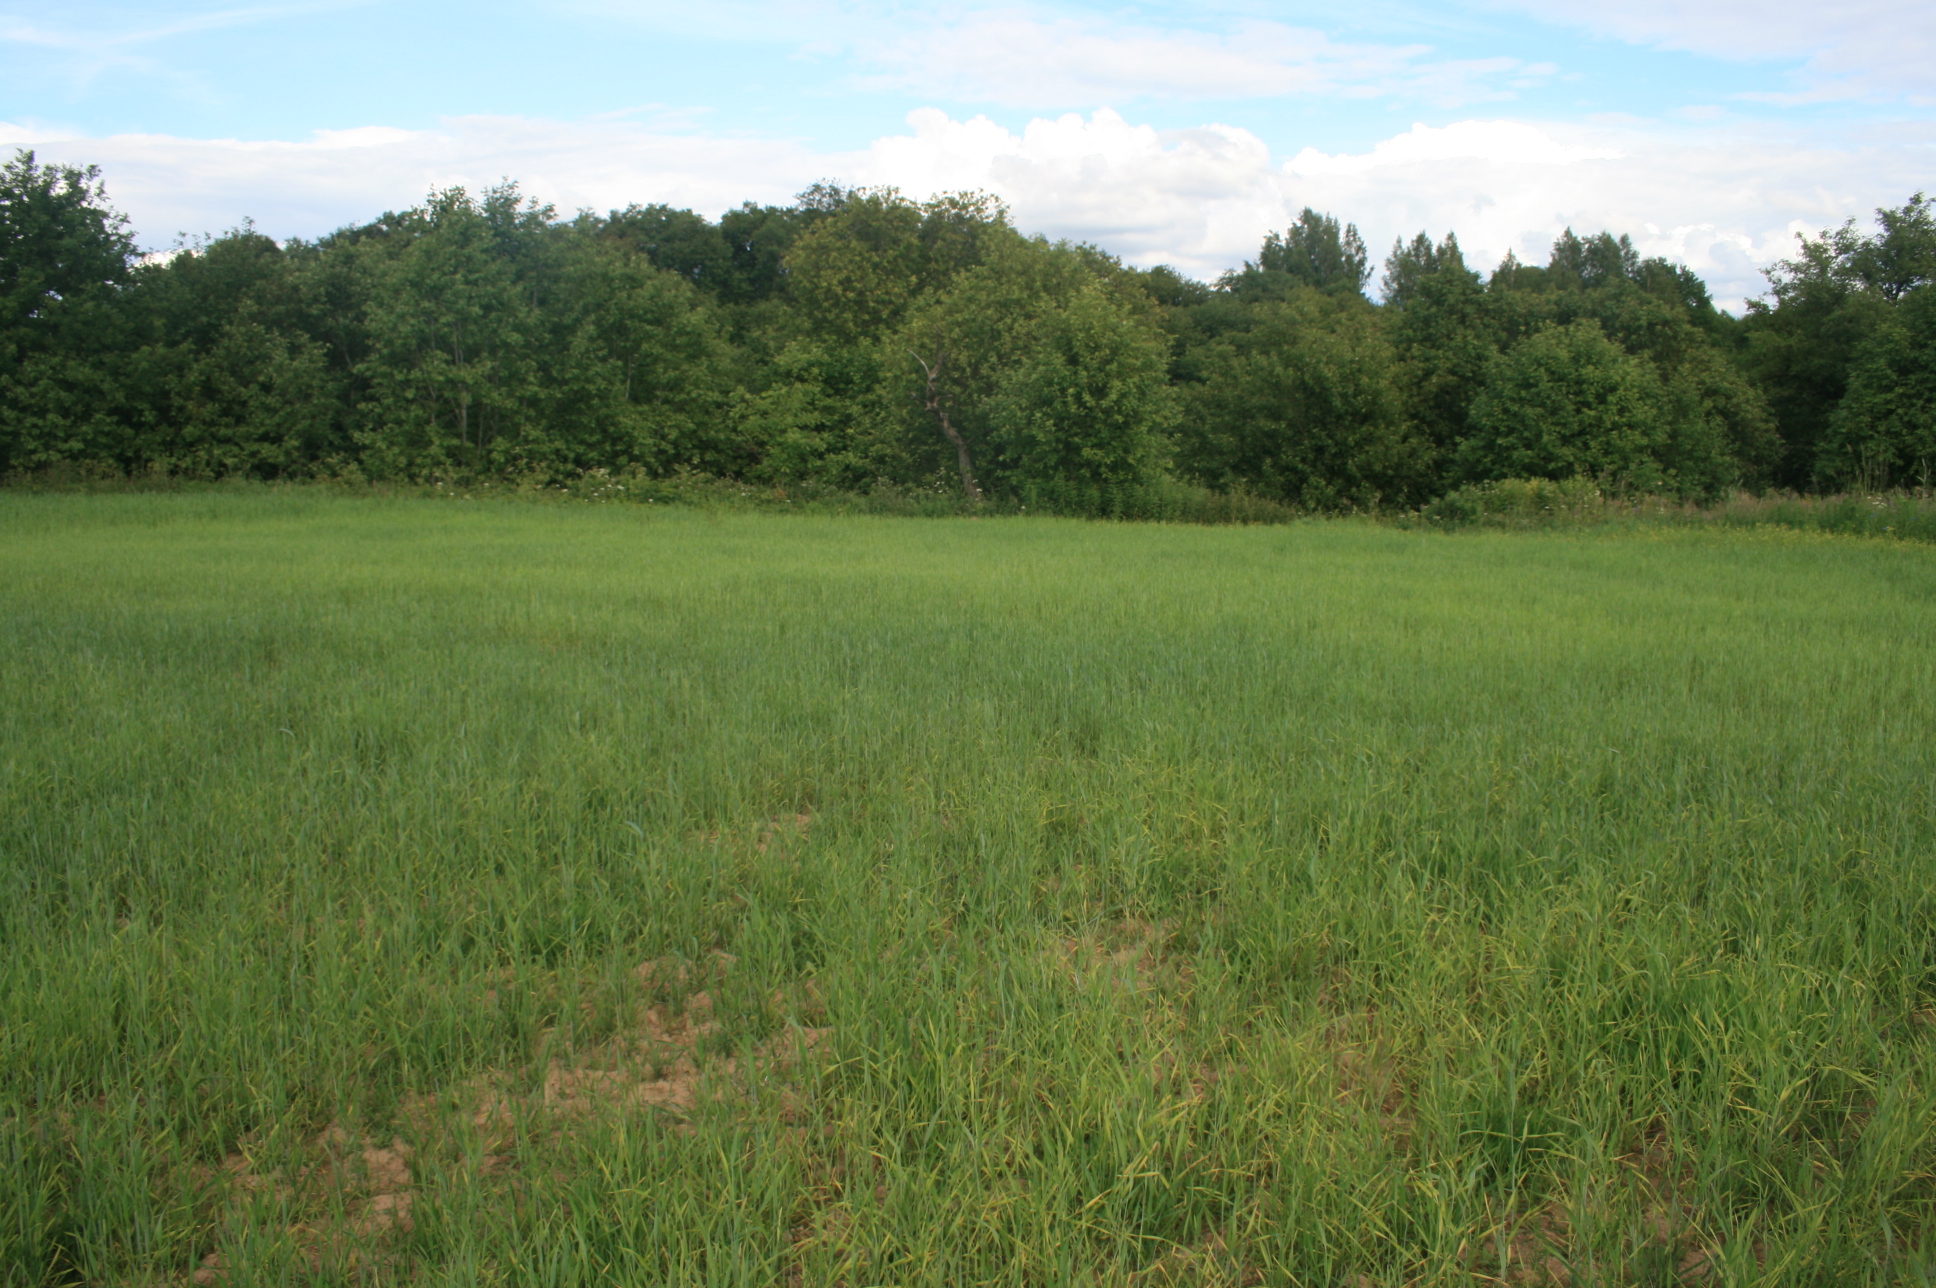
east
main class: Cropland
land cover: Barley
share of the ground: > 75 %
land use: Agriculture (excluding fallow land and kitchen gardens)
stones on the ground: < 10 %
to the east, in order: Barley; Spontaneously vegetated surfaces; Broadleaved woodland; Spontaneously vegetated surfaces; Rivers and streams; Spontaneously vegetated surfaces; Broadleaved woodland; Spontaneously vegetated surfaces; Tracks; Common wheat; Tracks; Broadleaved woodland
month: June
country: LT
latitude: 55.1052
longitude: 22.0775
